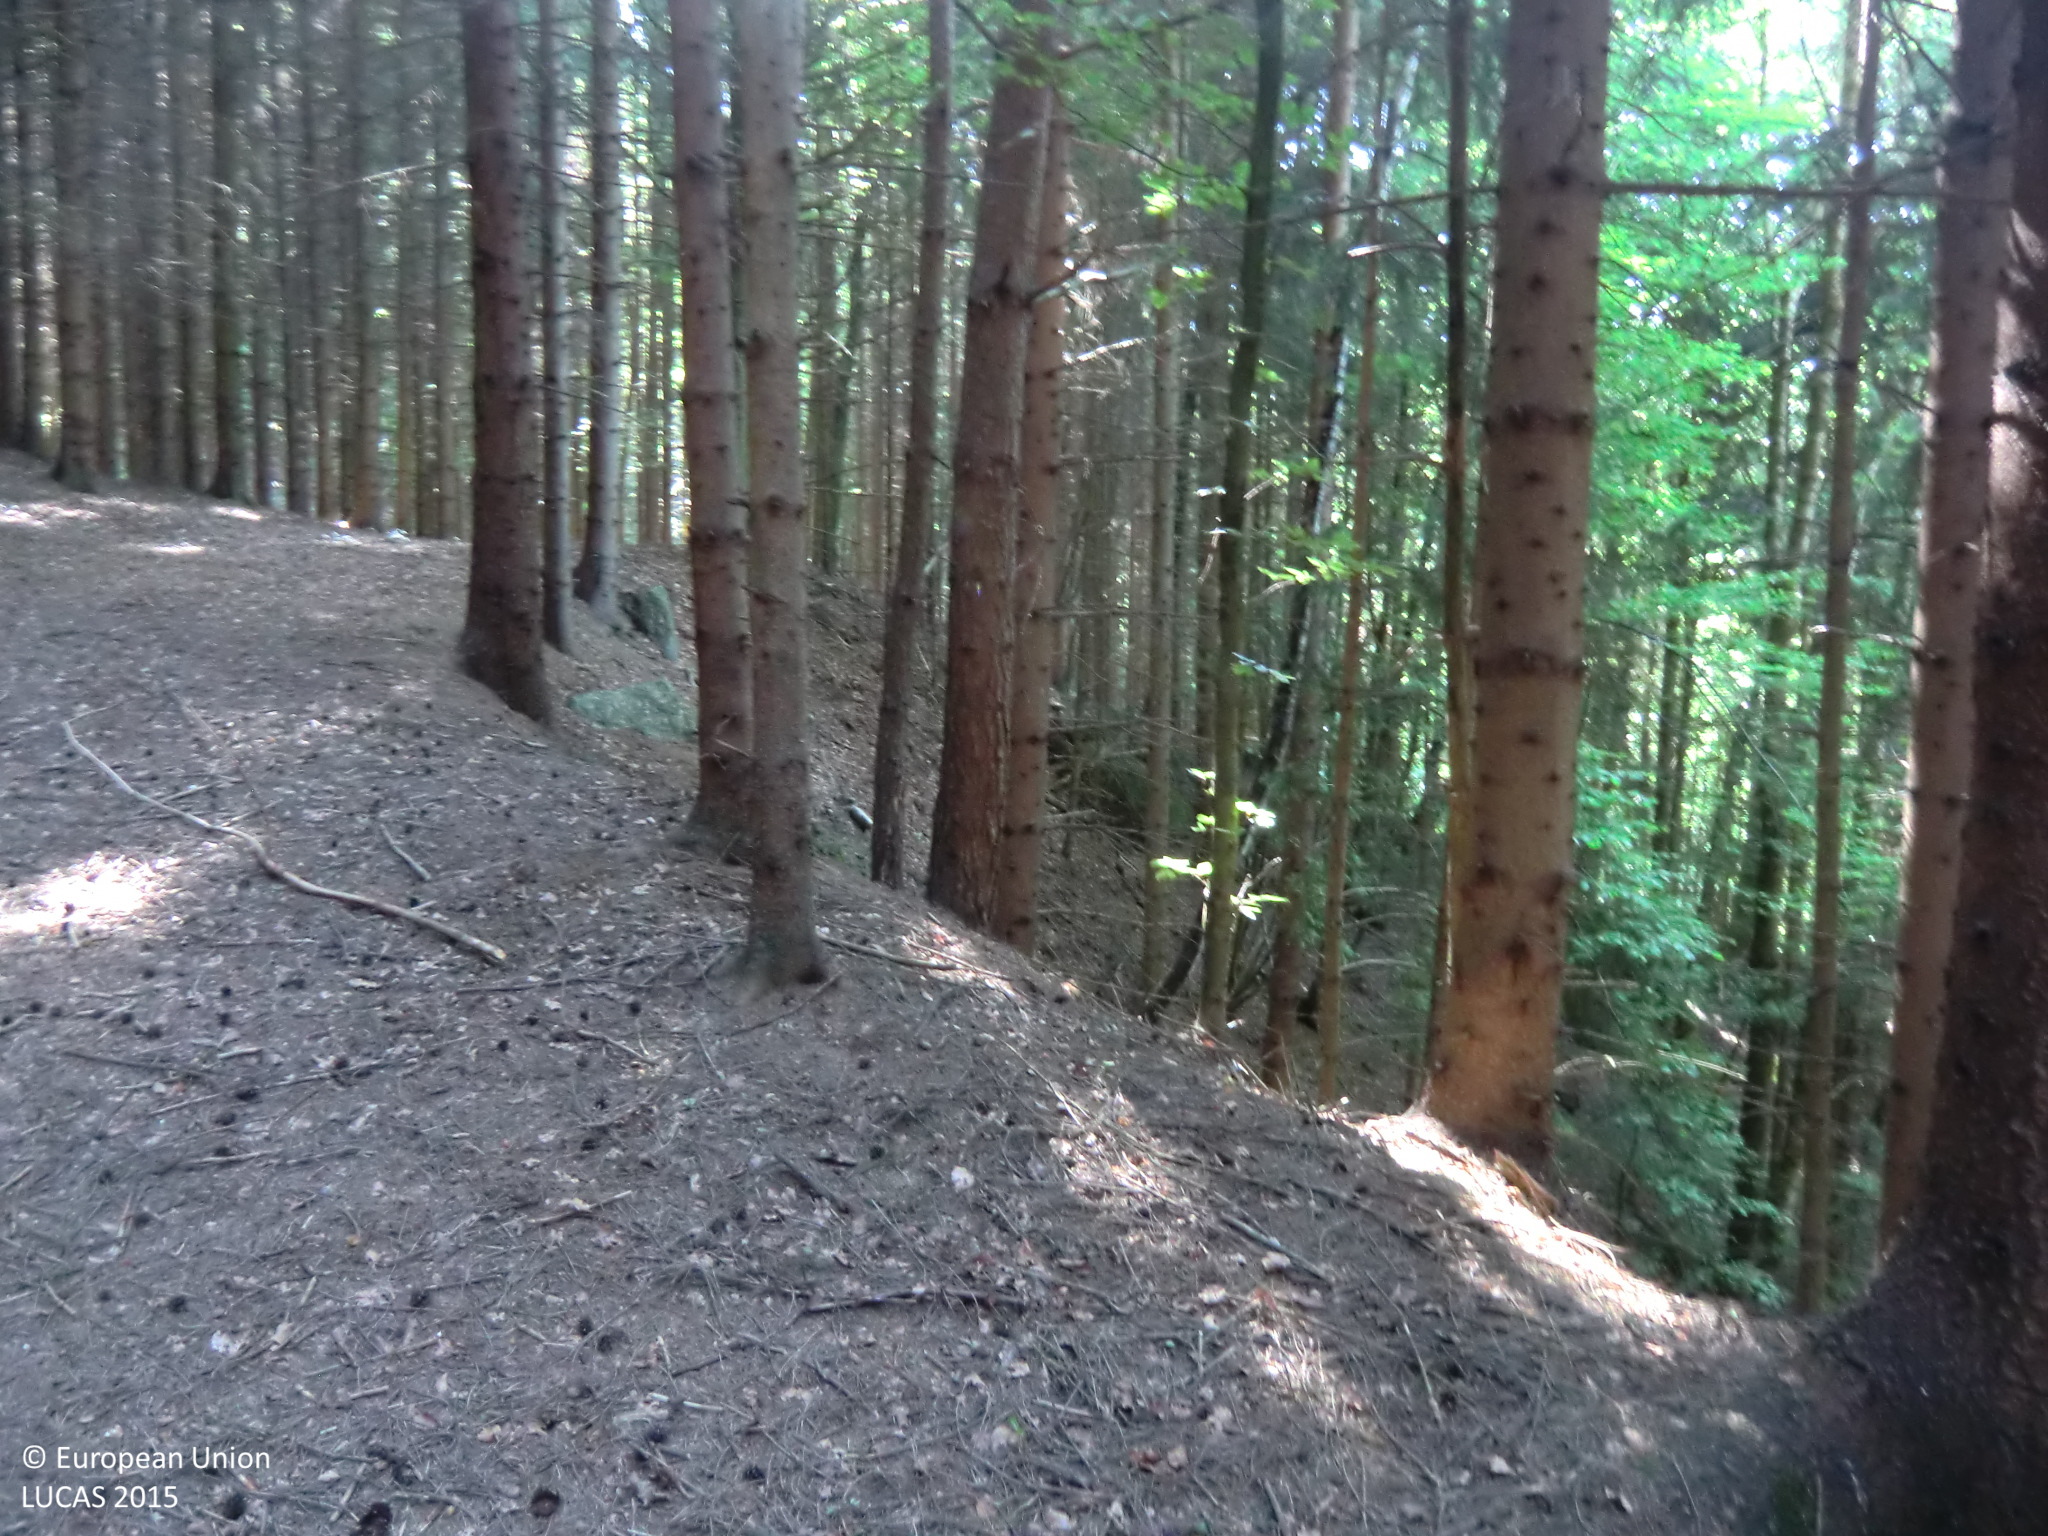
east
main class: Woodland
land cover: Spruce dominated coniferous woodland
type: hemiboreal forest and nemoral coniferous forest and mixed broadleaved-coniferous forest
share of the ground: > 75 %
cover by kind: coniferous forest trees 80 %, unconsolidated bare surface 20 %
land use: Forestry
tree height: > 5 m
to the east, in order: Spruce dominated coniferous woodland; Rivers and streams; Spruce dominated mixed woodland; Tracks; Spruce dominated mixed woodland; Tracks; Spruce dominated mixed woodland; Rivers and streams; Spruce dominated mixed woodland
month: June
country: AT
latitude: 48.2724
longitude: 15.0000
